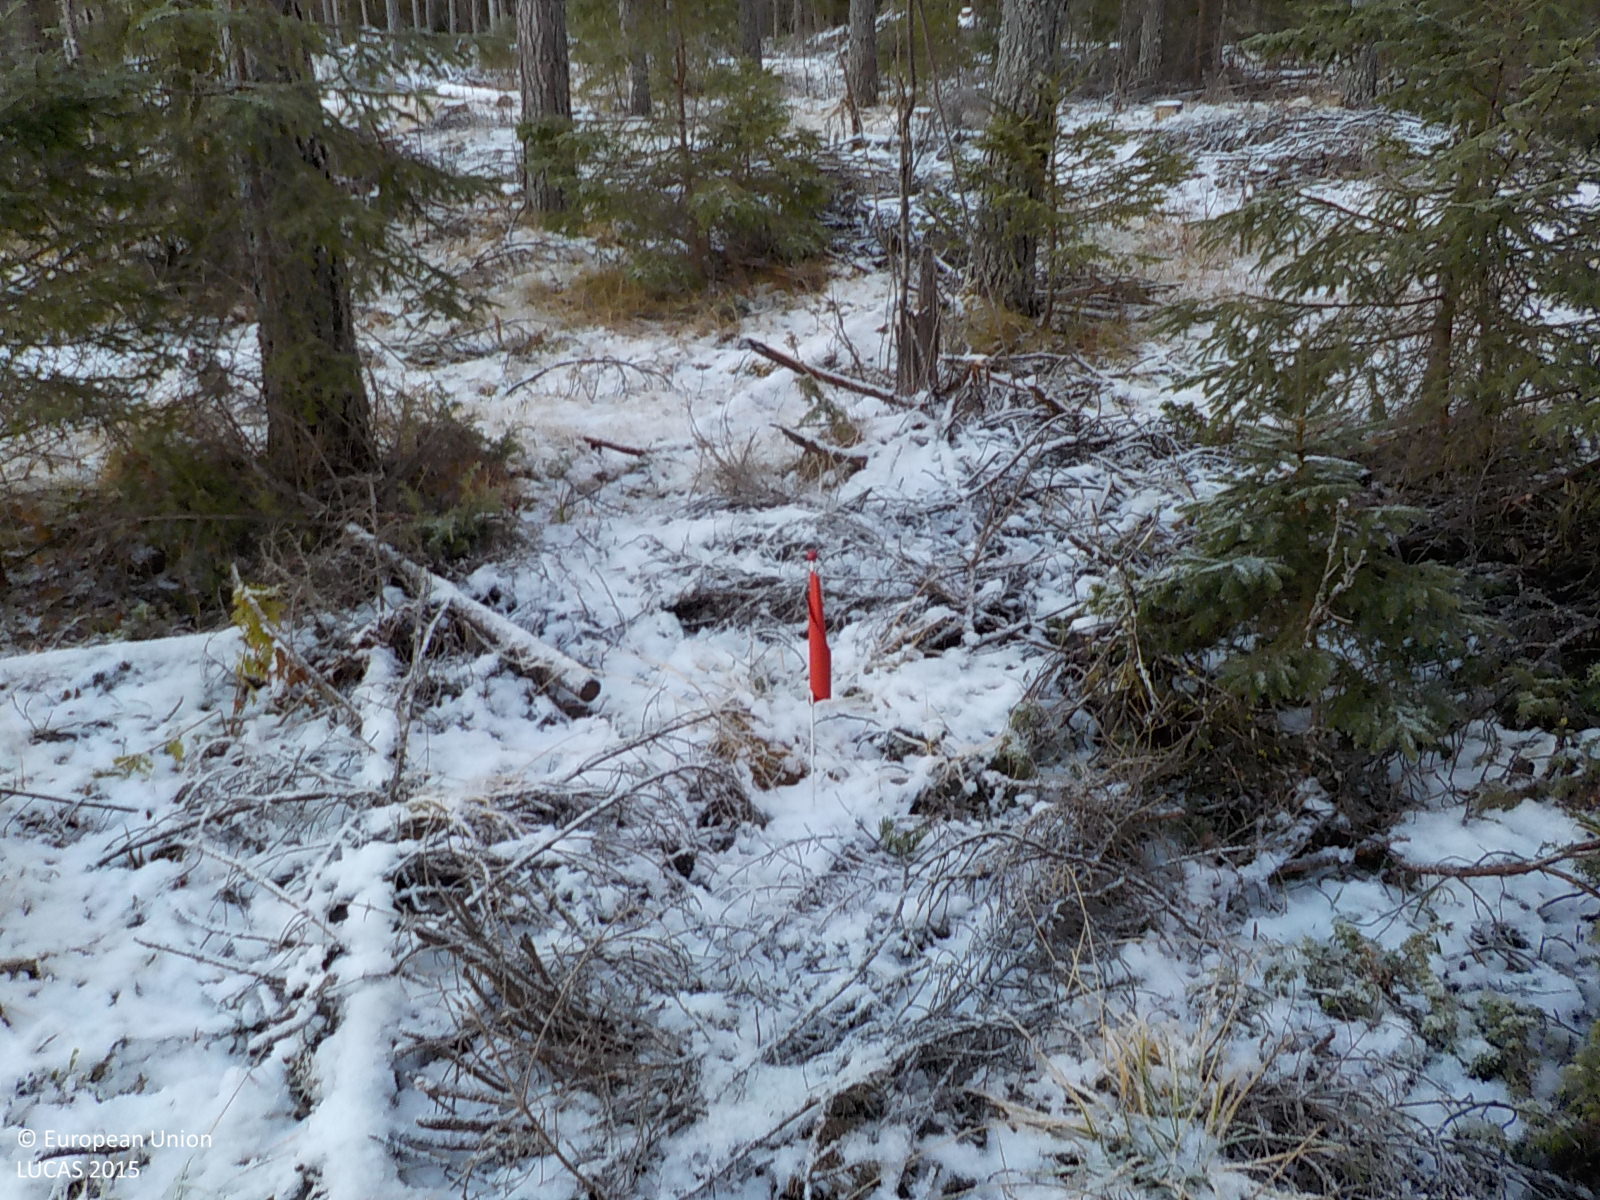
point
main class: Woodland
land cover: Pine dominated coniferous woodland
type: boreal forest
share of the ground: > 75 %
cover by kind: coniferous forest trees 75 %, shrubs 10 %, herbaceous plants 10 %, lichens and mosses 5 %
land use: Forestry
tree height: > 5 m
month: December
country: SE
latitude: 63.2981
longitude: 16.6572
